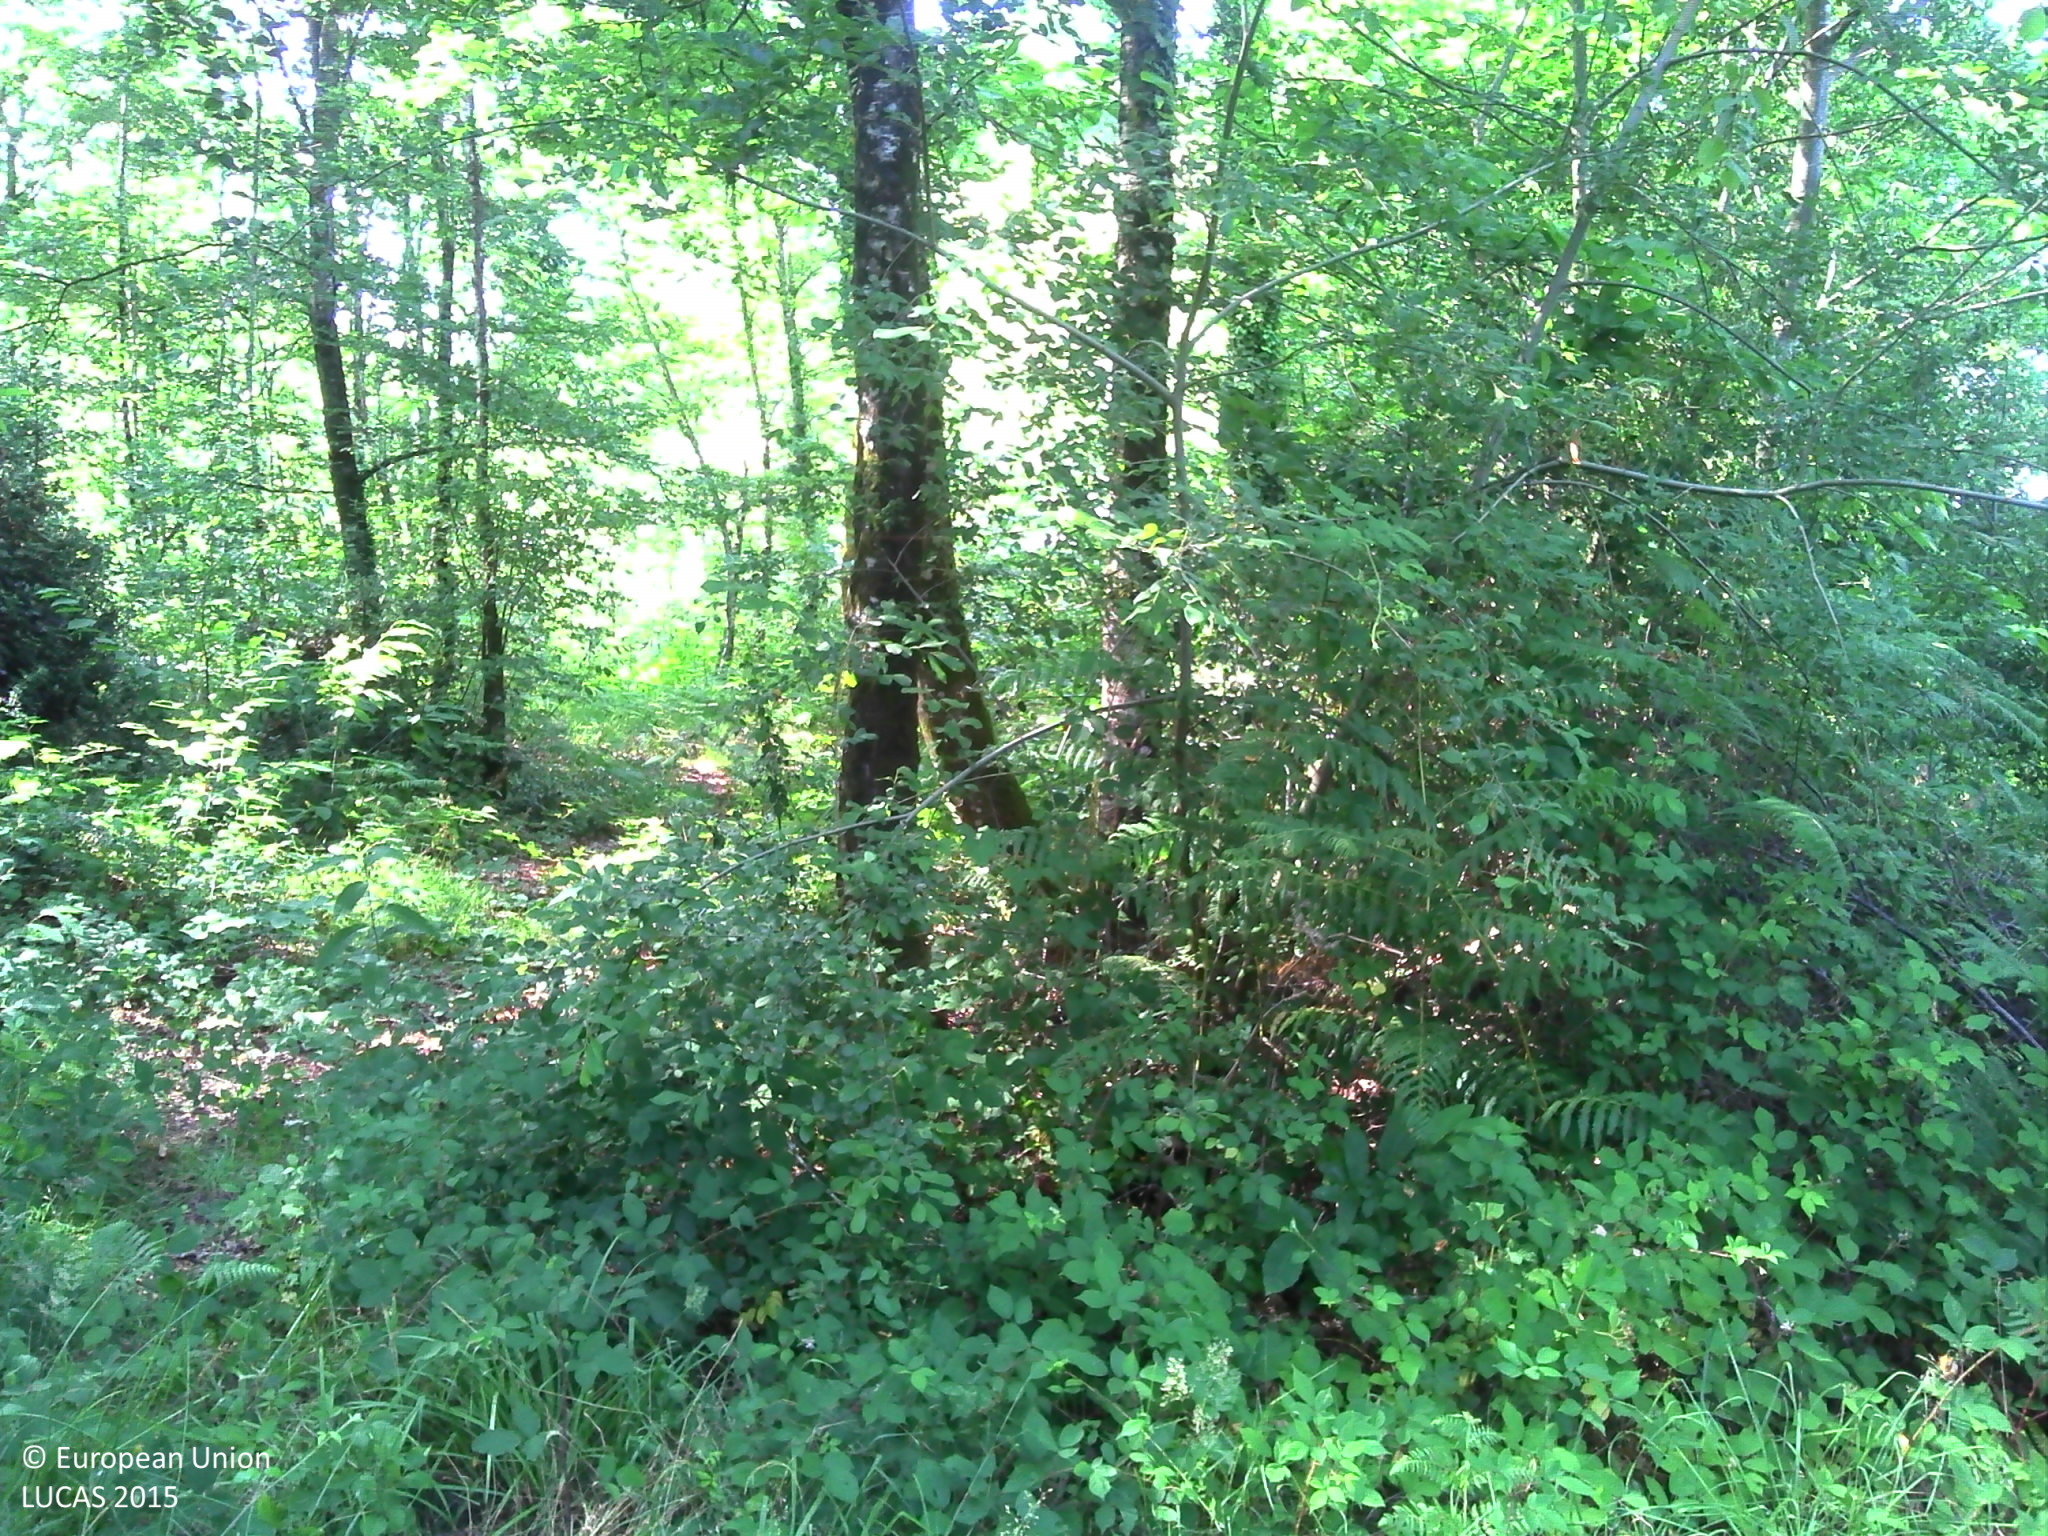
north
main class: Woodland
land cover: Broadleaved woodland
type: mesophytic deciduous forest
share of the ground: > 75 %
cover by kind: broadleaved forest trees 80 %, shrubs 10 %, herbaceous plants 10 %
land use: Forestry
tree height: > 5 m
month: July
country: FR
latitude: 47.7847
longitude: -3.2447
